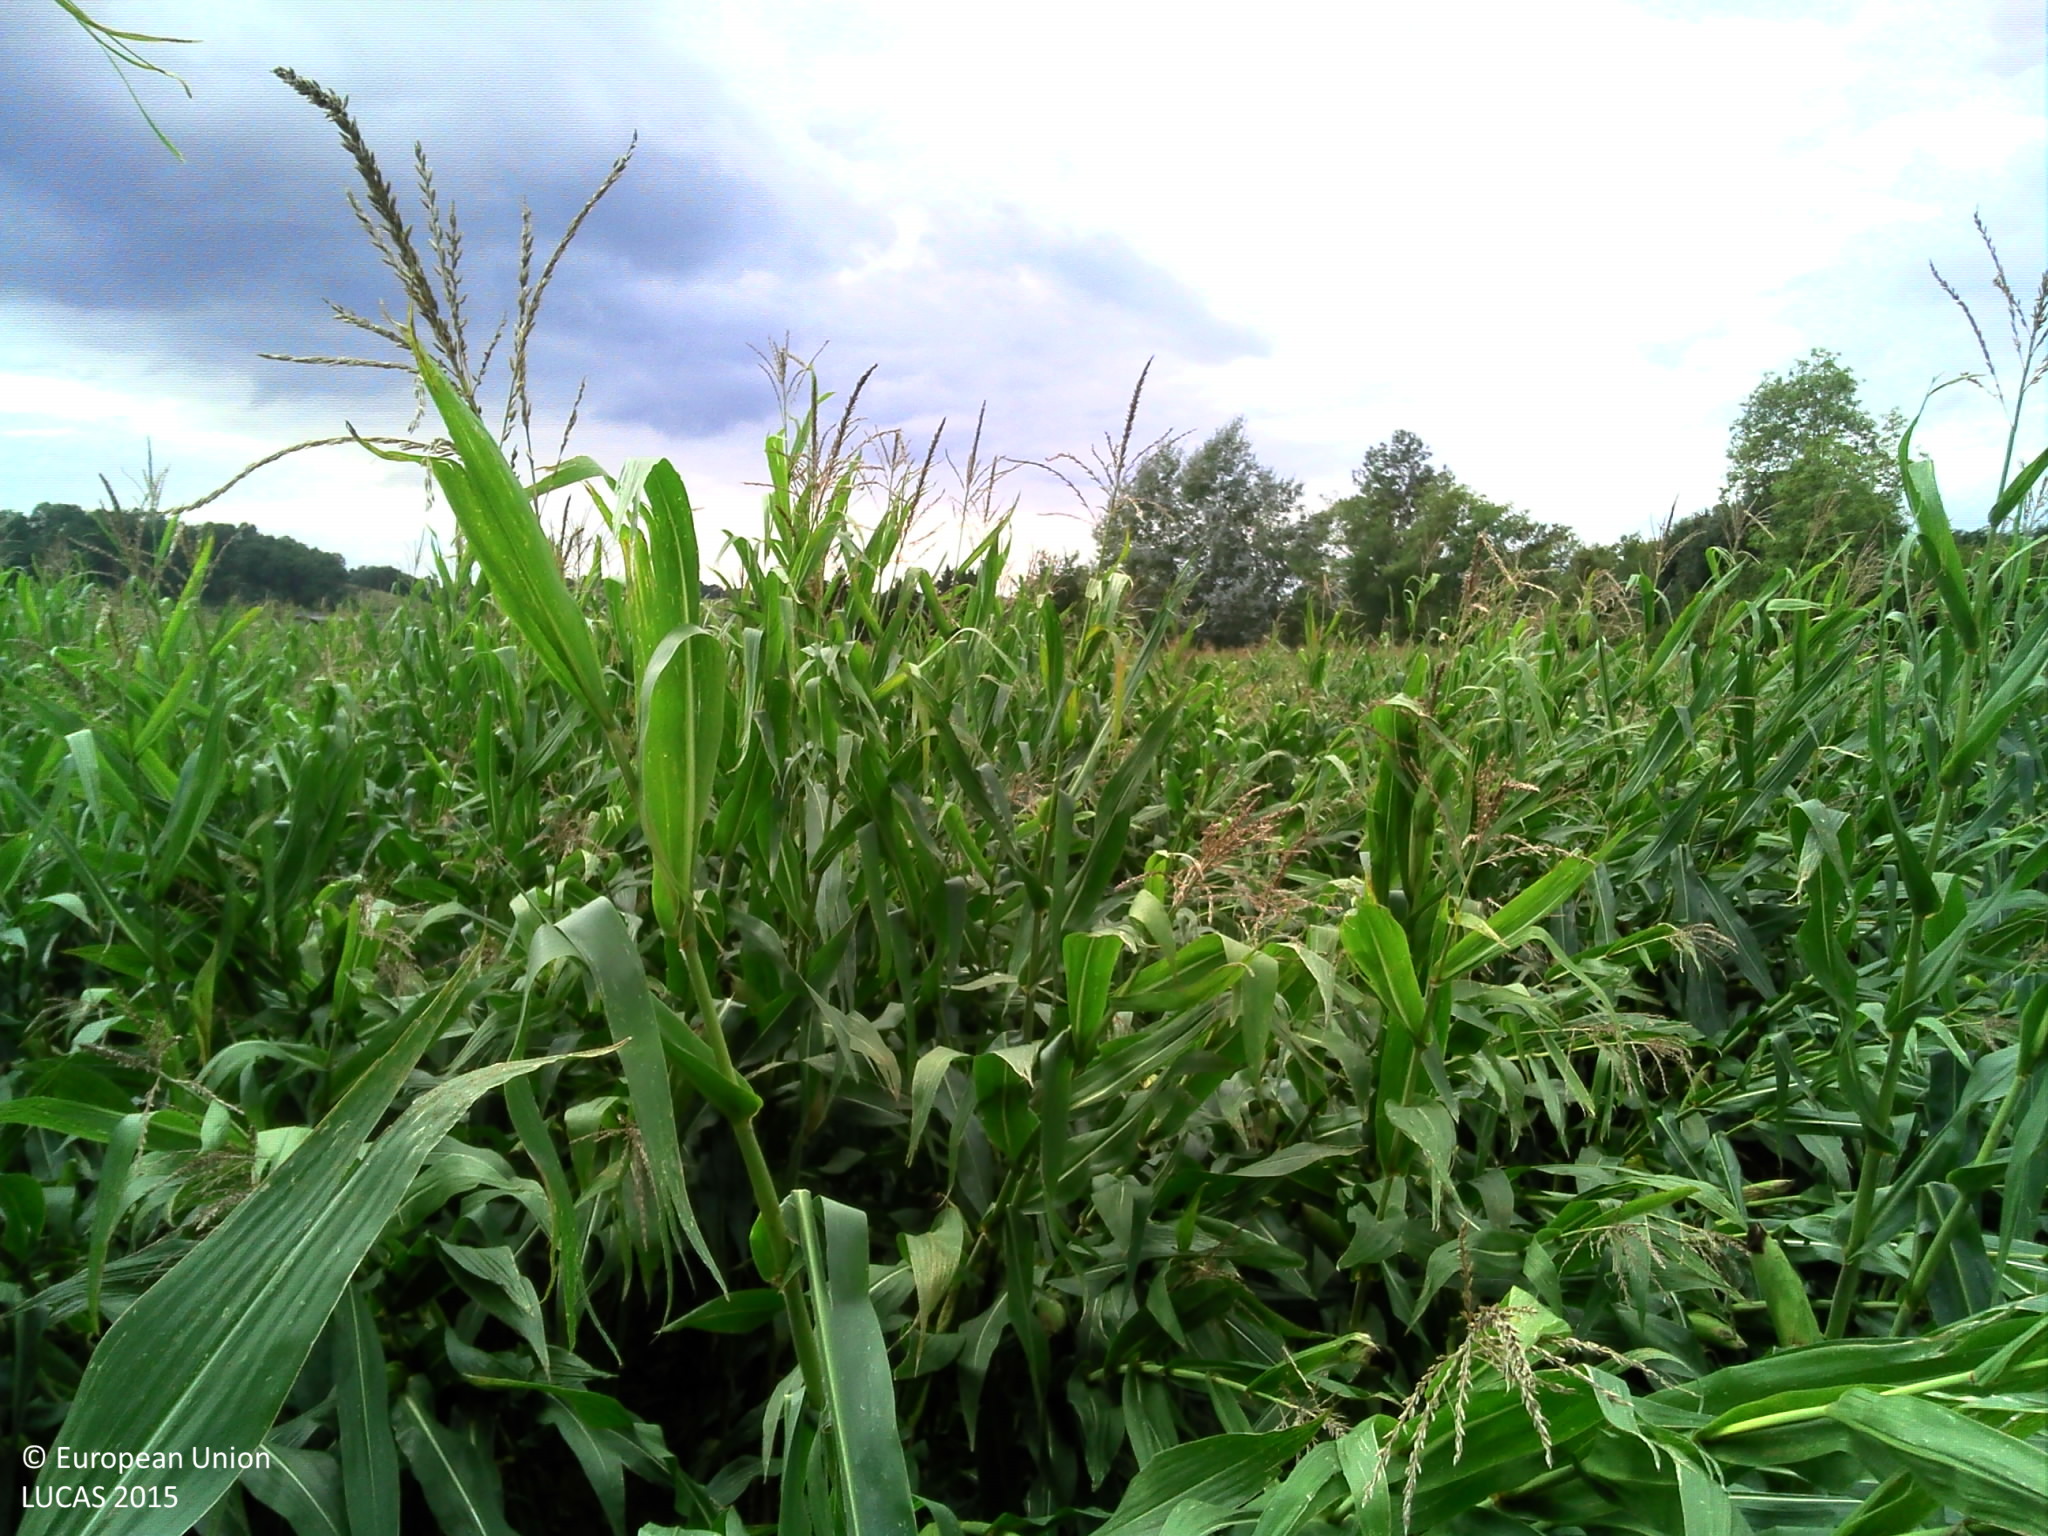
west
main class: Cropland
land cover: Maize
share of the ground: > 75 %
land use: Agriculture (excluding fallow land and kitchen gardens)
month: September
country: FR
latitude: 43.5138
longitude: -0.4370
